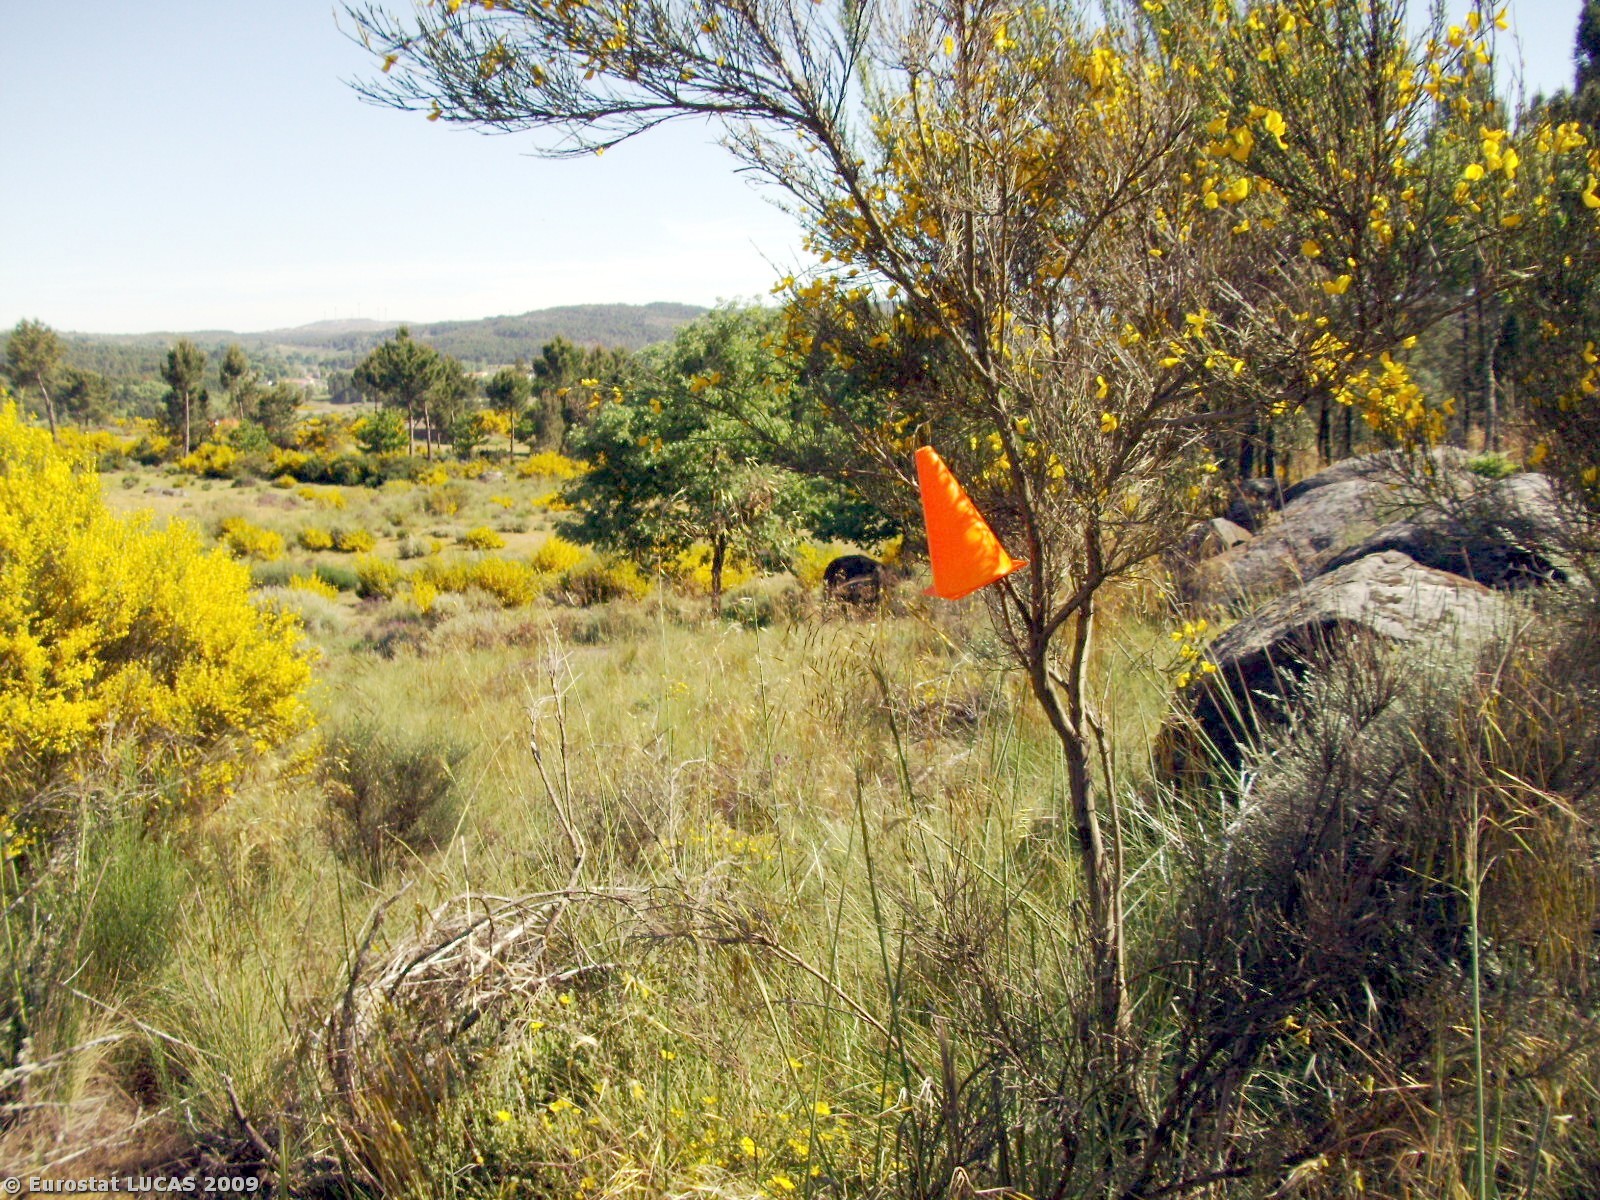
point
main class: Shrubland
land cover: Shrubland with sparse tree cover
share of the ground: > 75 %
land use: Unused
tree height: > 5 m
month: May
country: PT
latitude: 40.7660
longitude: -7.3971
